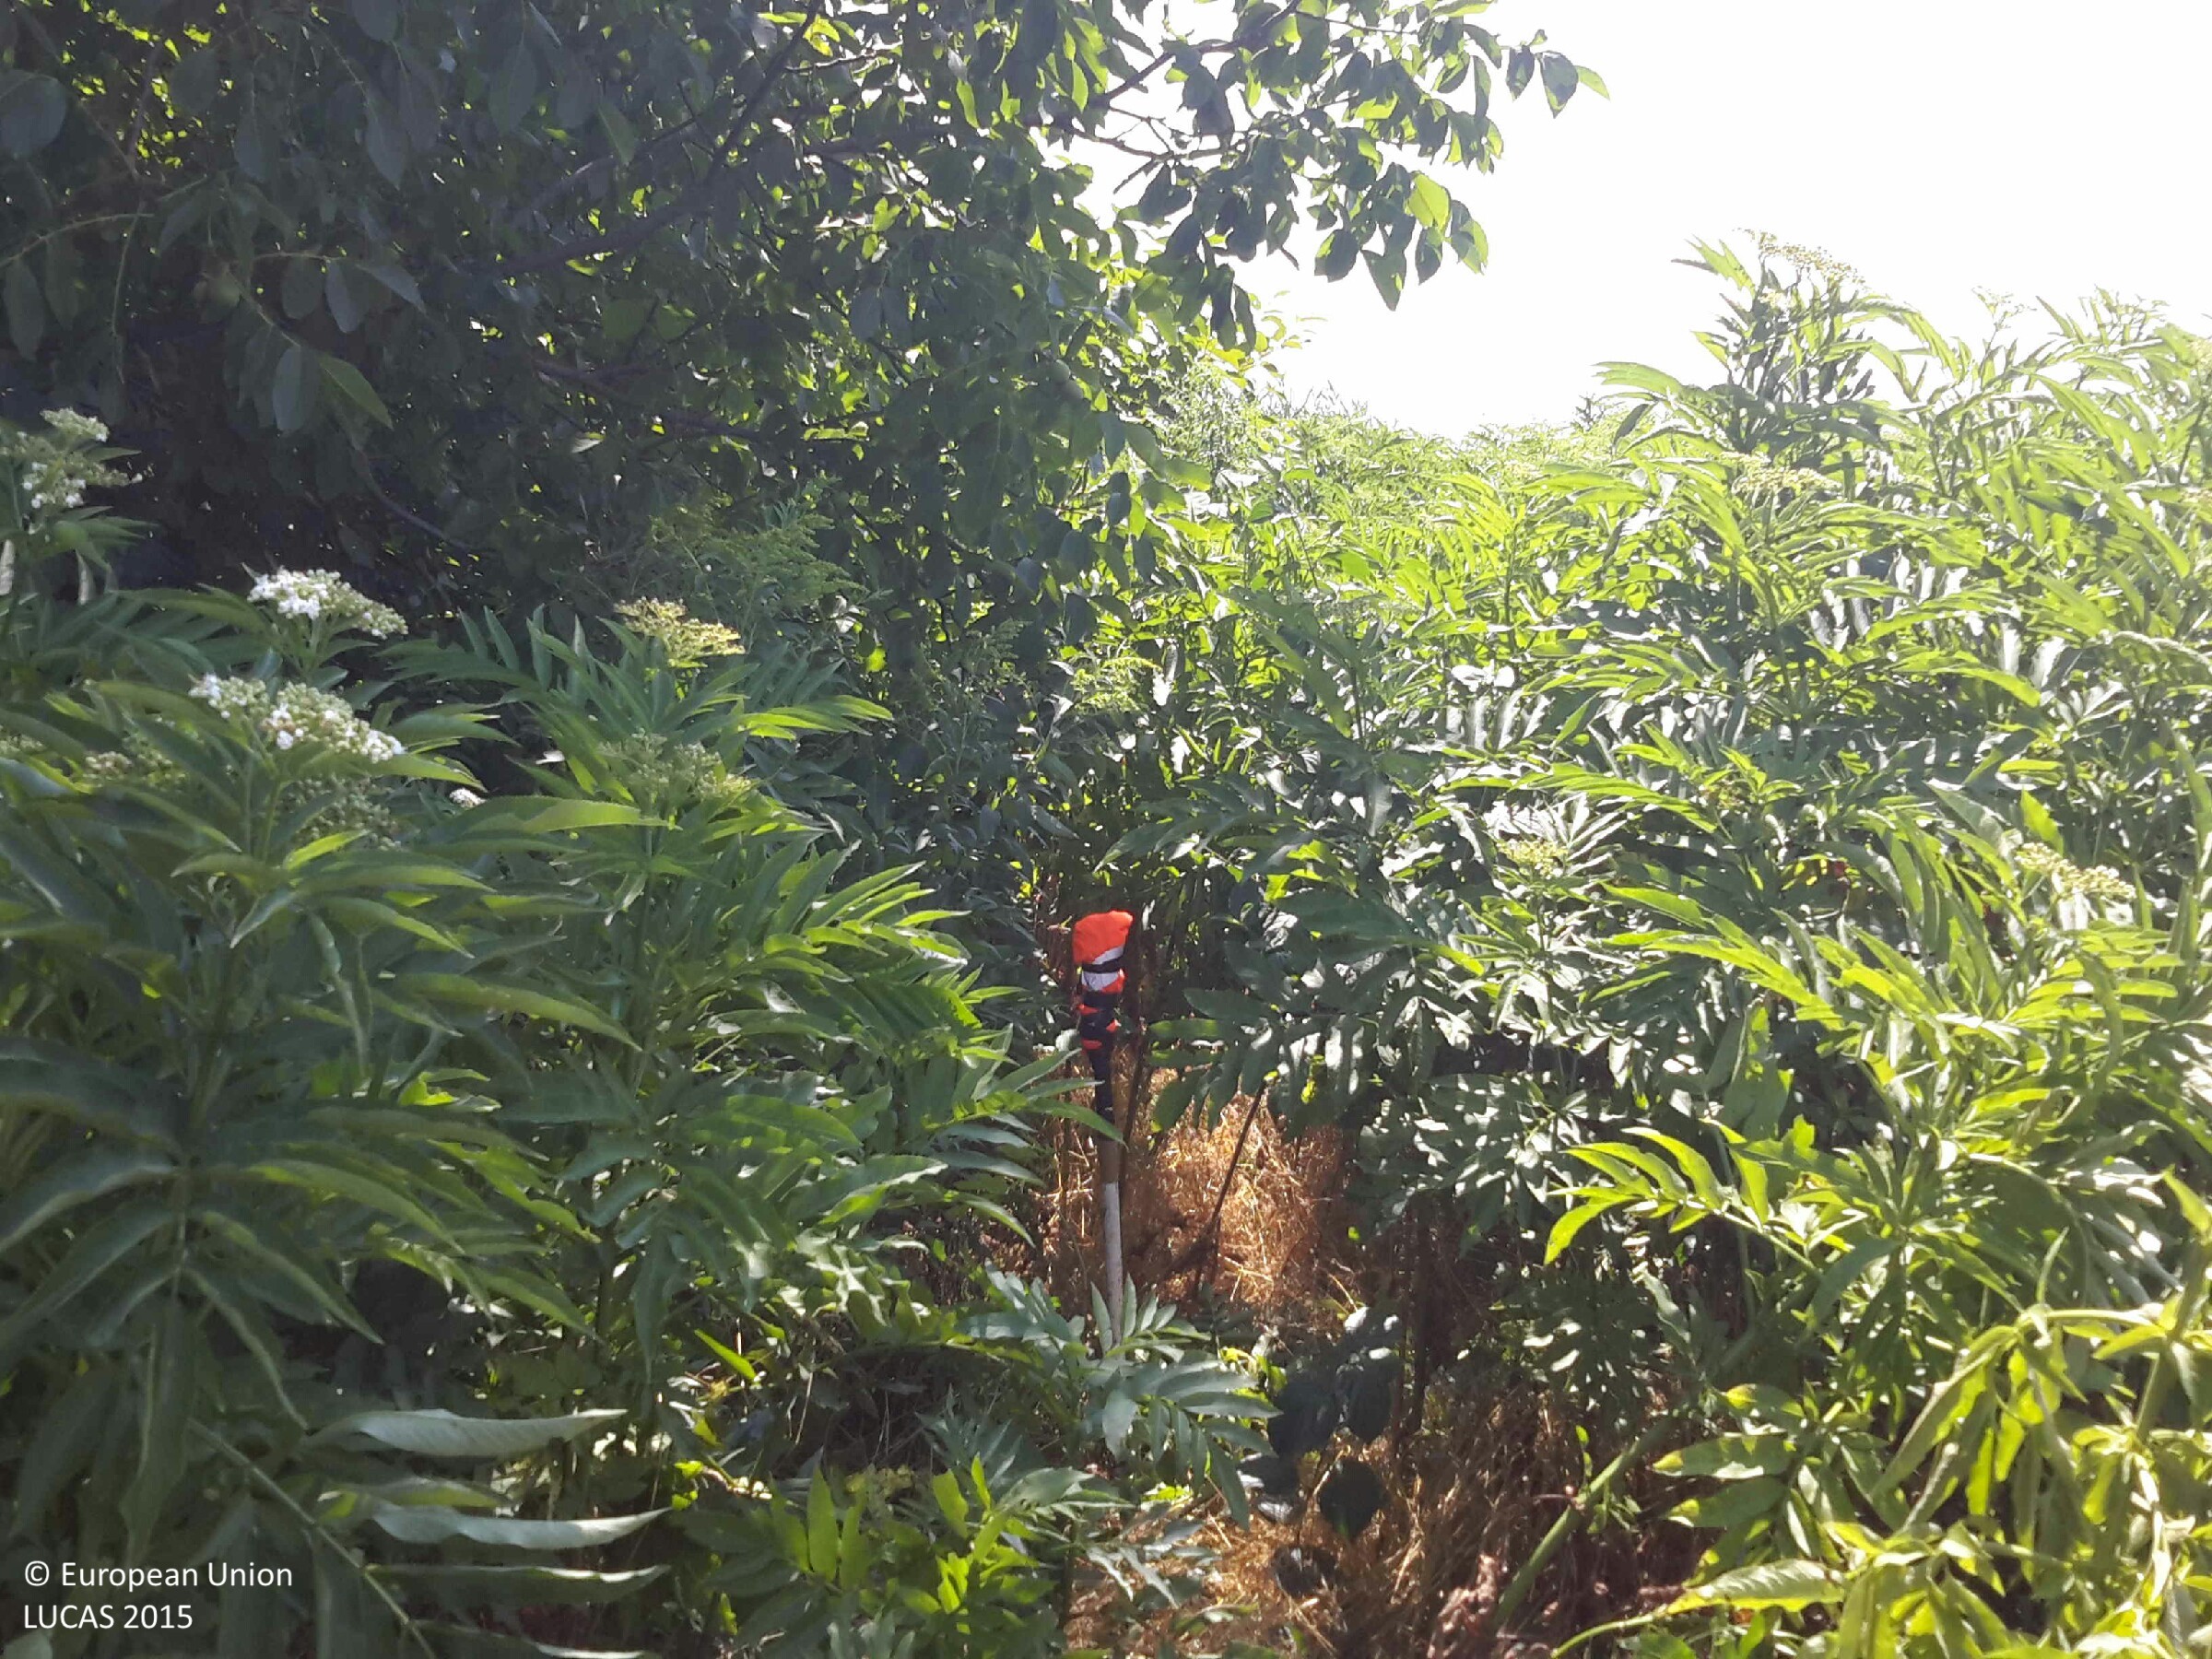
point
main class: Shrubland
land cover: Shrubland with sparse tree cover
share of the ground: 25 - 50 %
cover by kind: herbaceous plants 70 %, shrubs 25 %, broadleaved forest trees 5 %
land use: Semi-natural and natural areas not in use
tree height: > 5 m
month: July
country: HU
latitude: 47.4393
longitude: 17.8197
